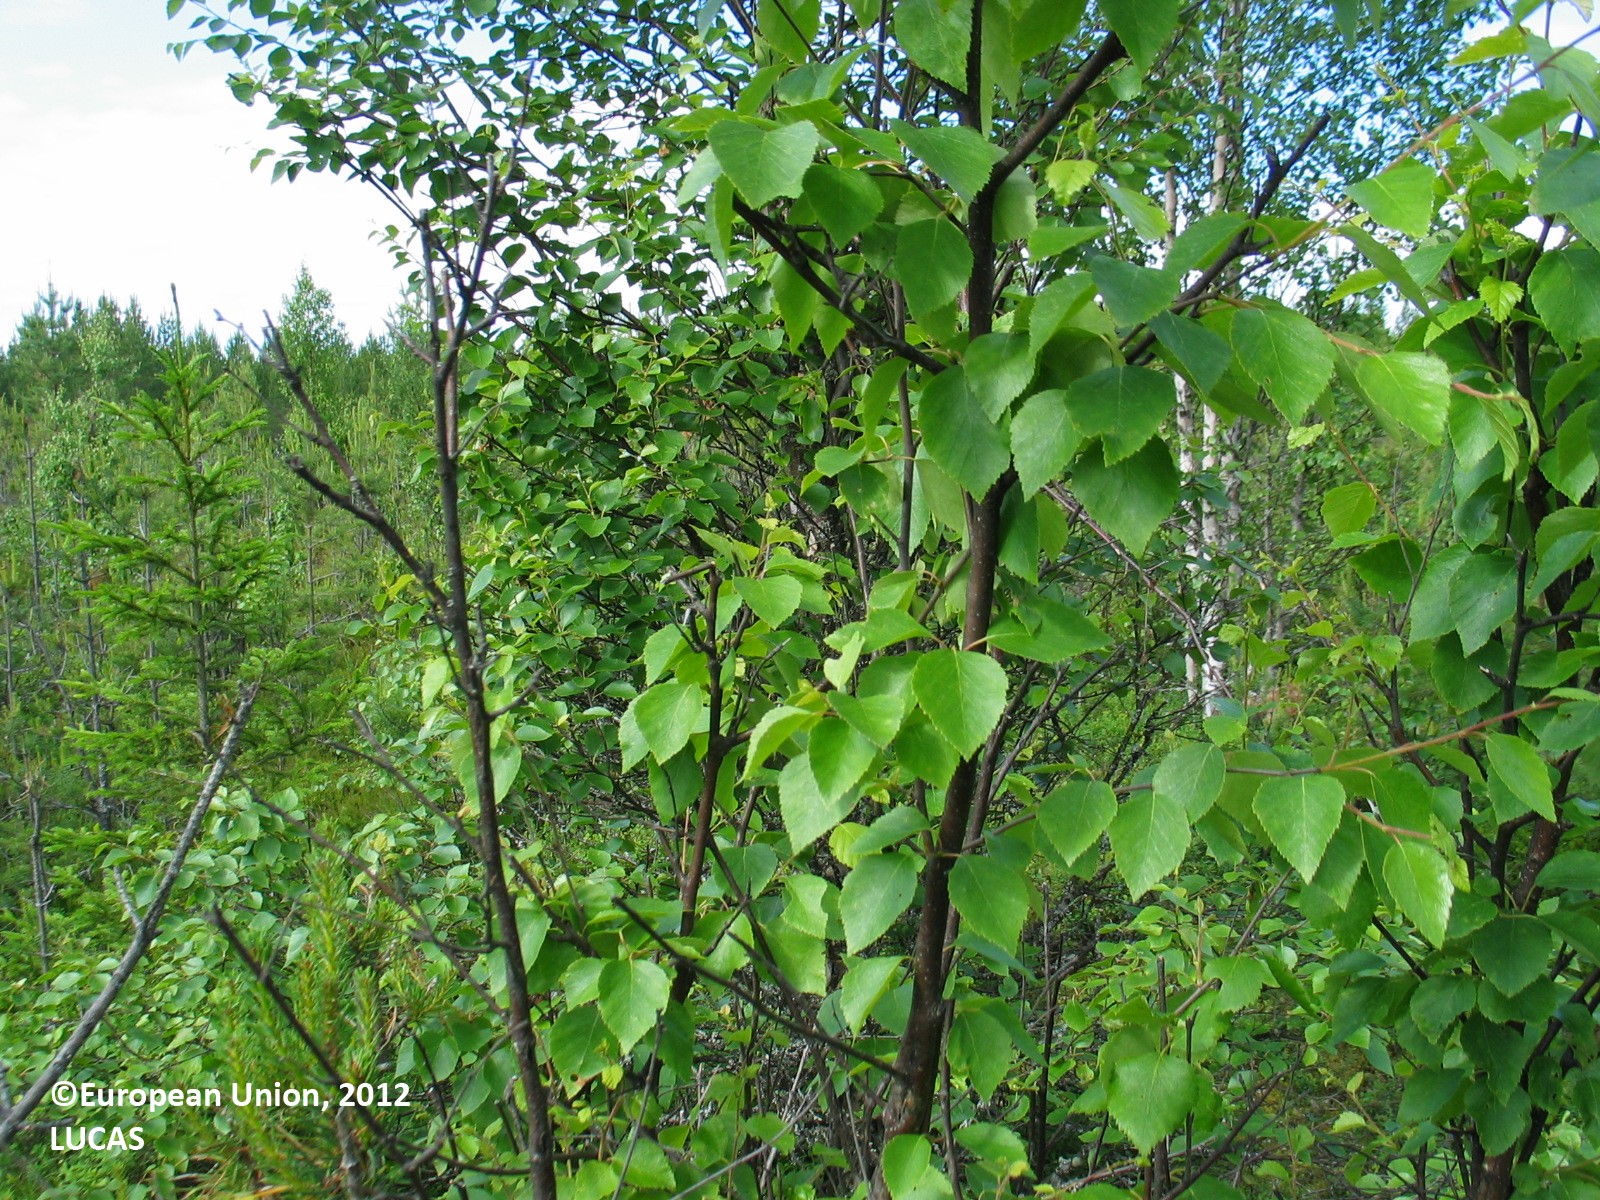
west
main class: Woodland
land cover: Other mixed woodland
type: boreal forest
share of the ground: 25 - 50 %
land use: Forestry
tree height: < 5 m
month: July
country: FI
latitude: 64.7563
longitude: 26.6114
